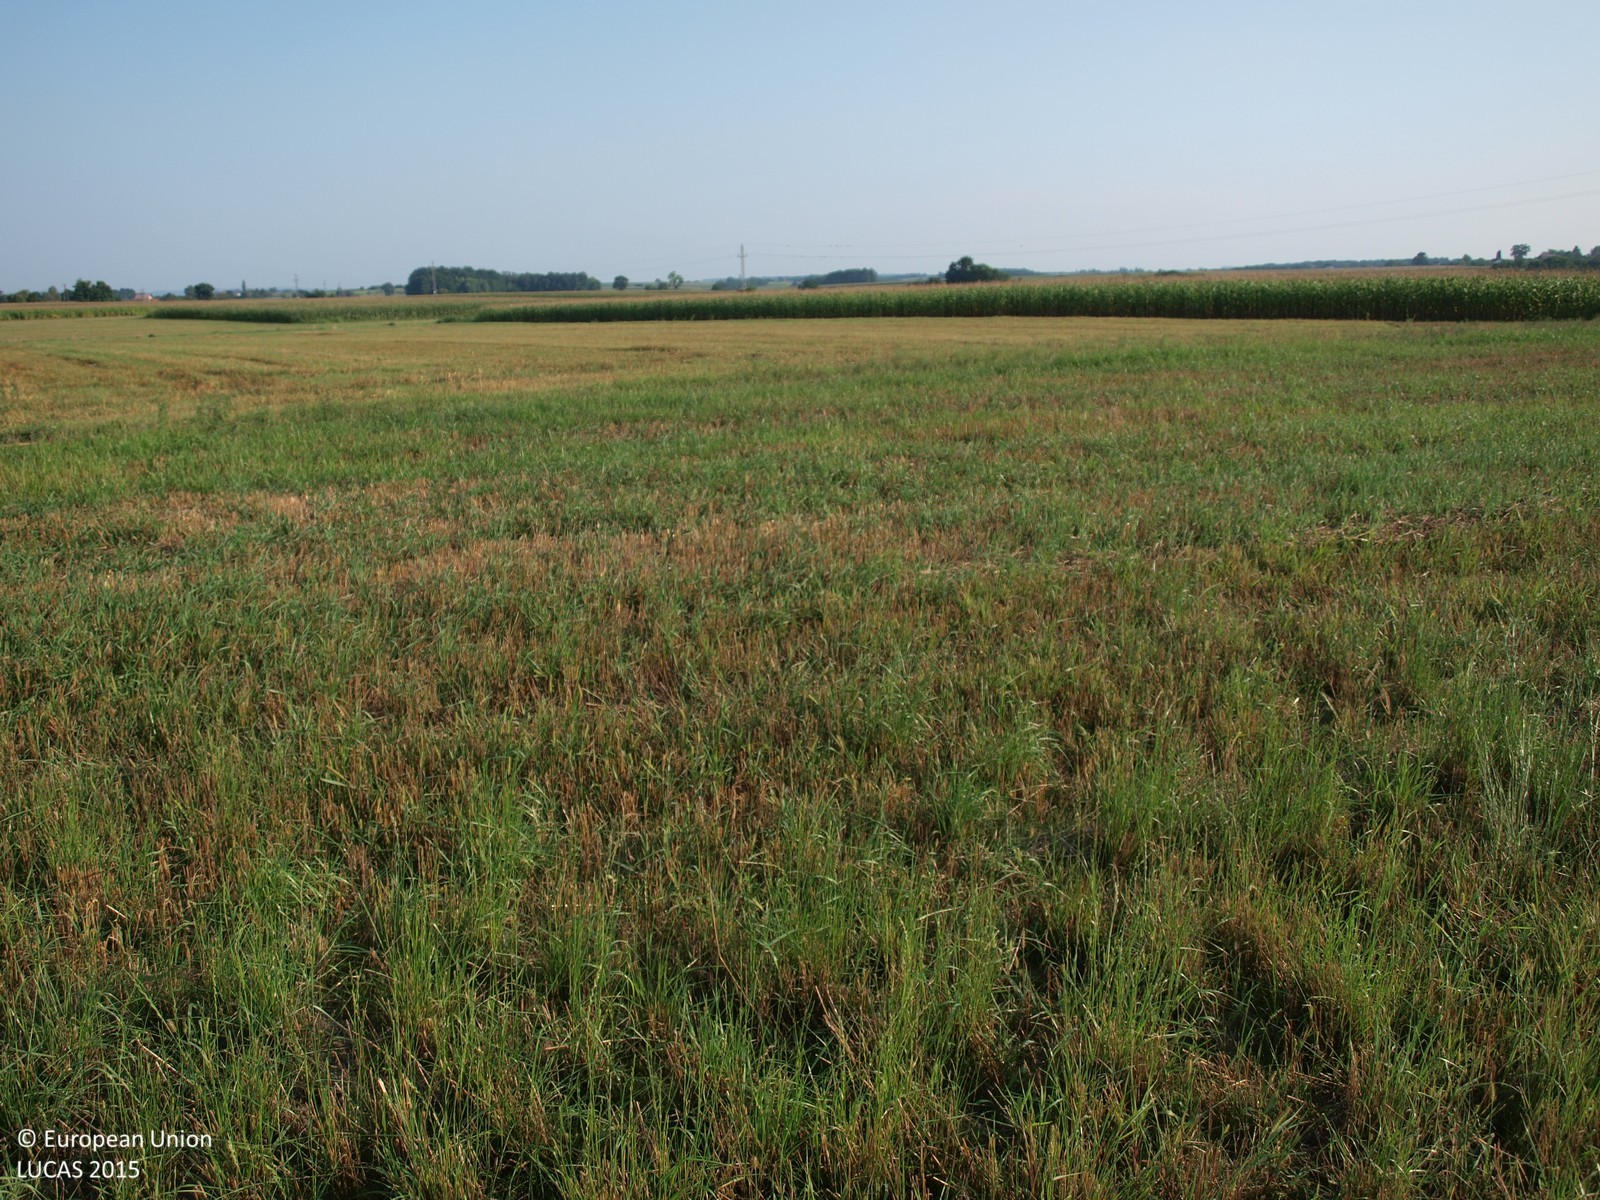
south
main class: Cropland
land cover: Oats
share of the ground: > 75 %
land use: Agriculture (excluding fallow land and kitchen gardens)
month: August
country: HR
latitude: 45.8250
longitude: 16.5511
